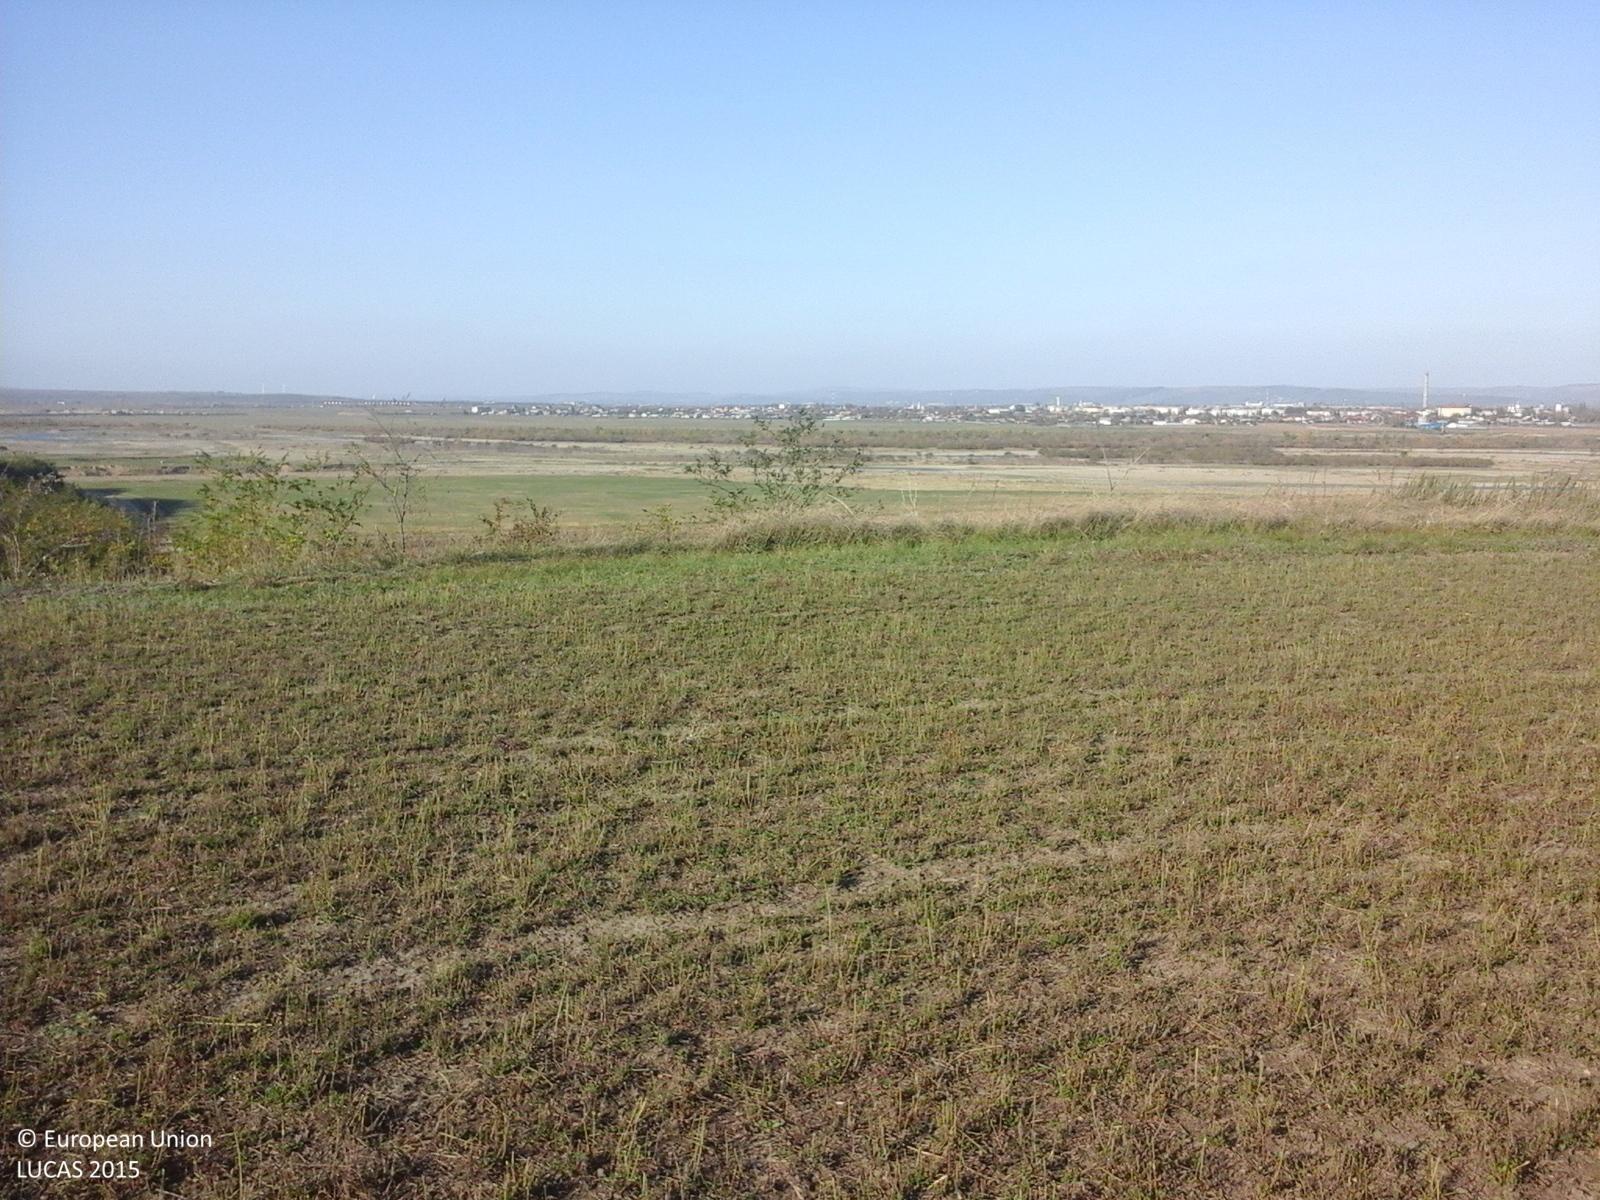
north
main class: Cropland
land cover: Lucerne
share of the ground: 50 - 75 %
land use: Agriculture (excluding fallow land and kitchen gardens)
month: October
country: RO
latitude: 46.0706
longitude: 27.1767
